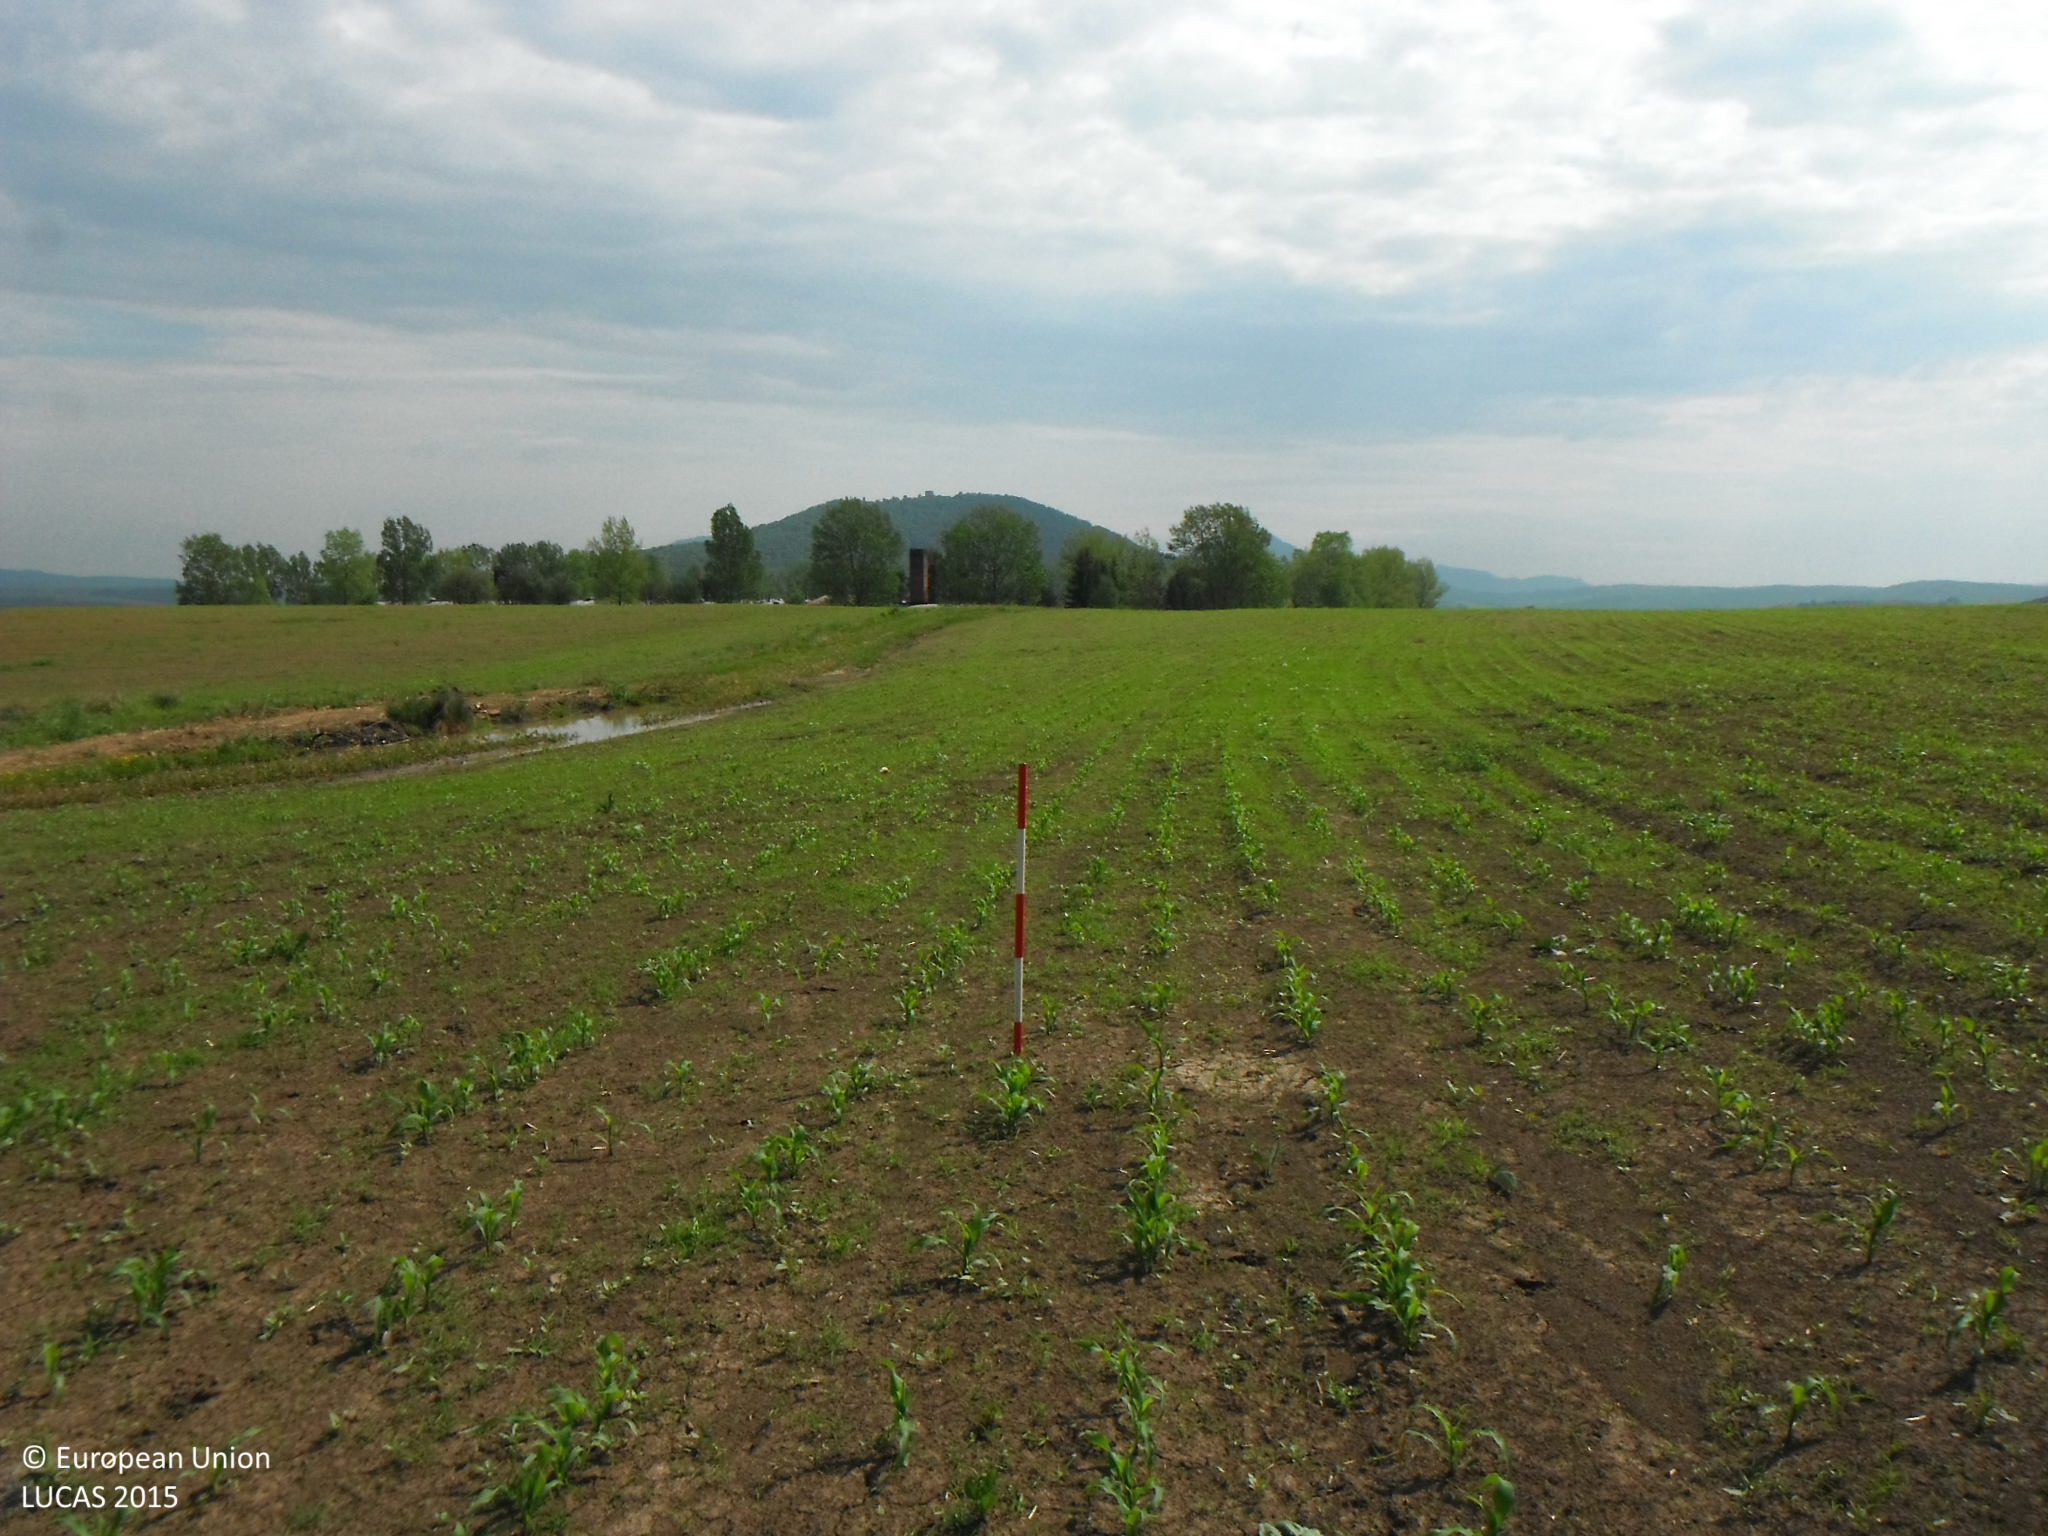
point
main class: Cropland
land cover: Maize
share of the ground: < 10 %
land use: Agriculture (excluding fallow land and kitchen gardens)
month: May
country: SK
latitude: 49.0375
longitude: 21.1375
